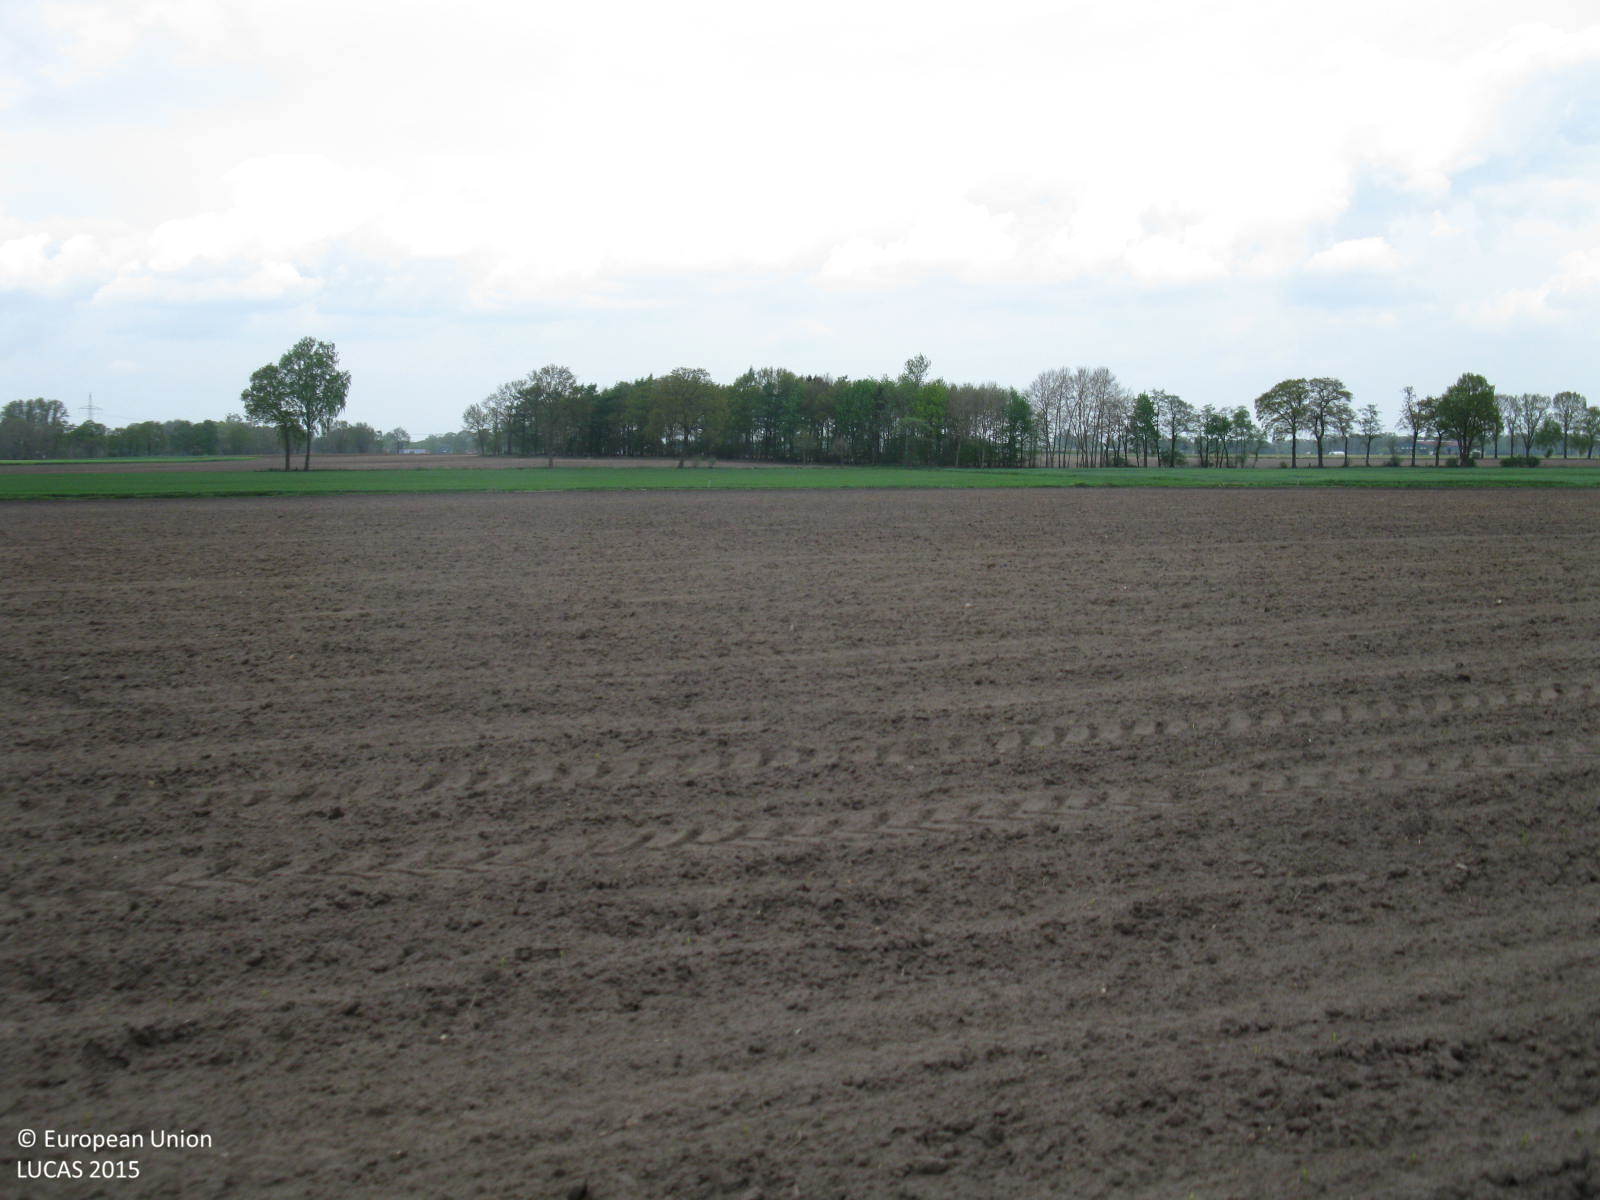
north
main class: Cropland
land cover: Maize
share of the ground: < 10 %
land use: Agriculture (excluding fallow land and kitchen gardens)
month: May
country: DE
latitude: 52.8265
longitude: 7.9080
